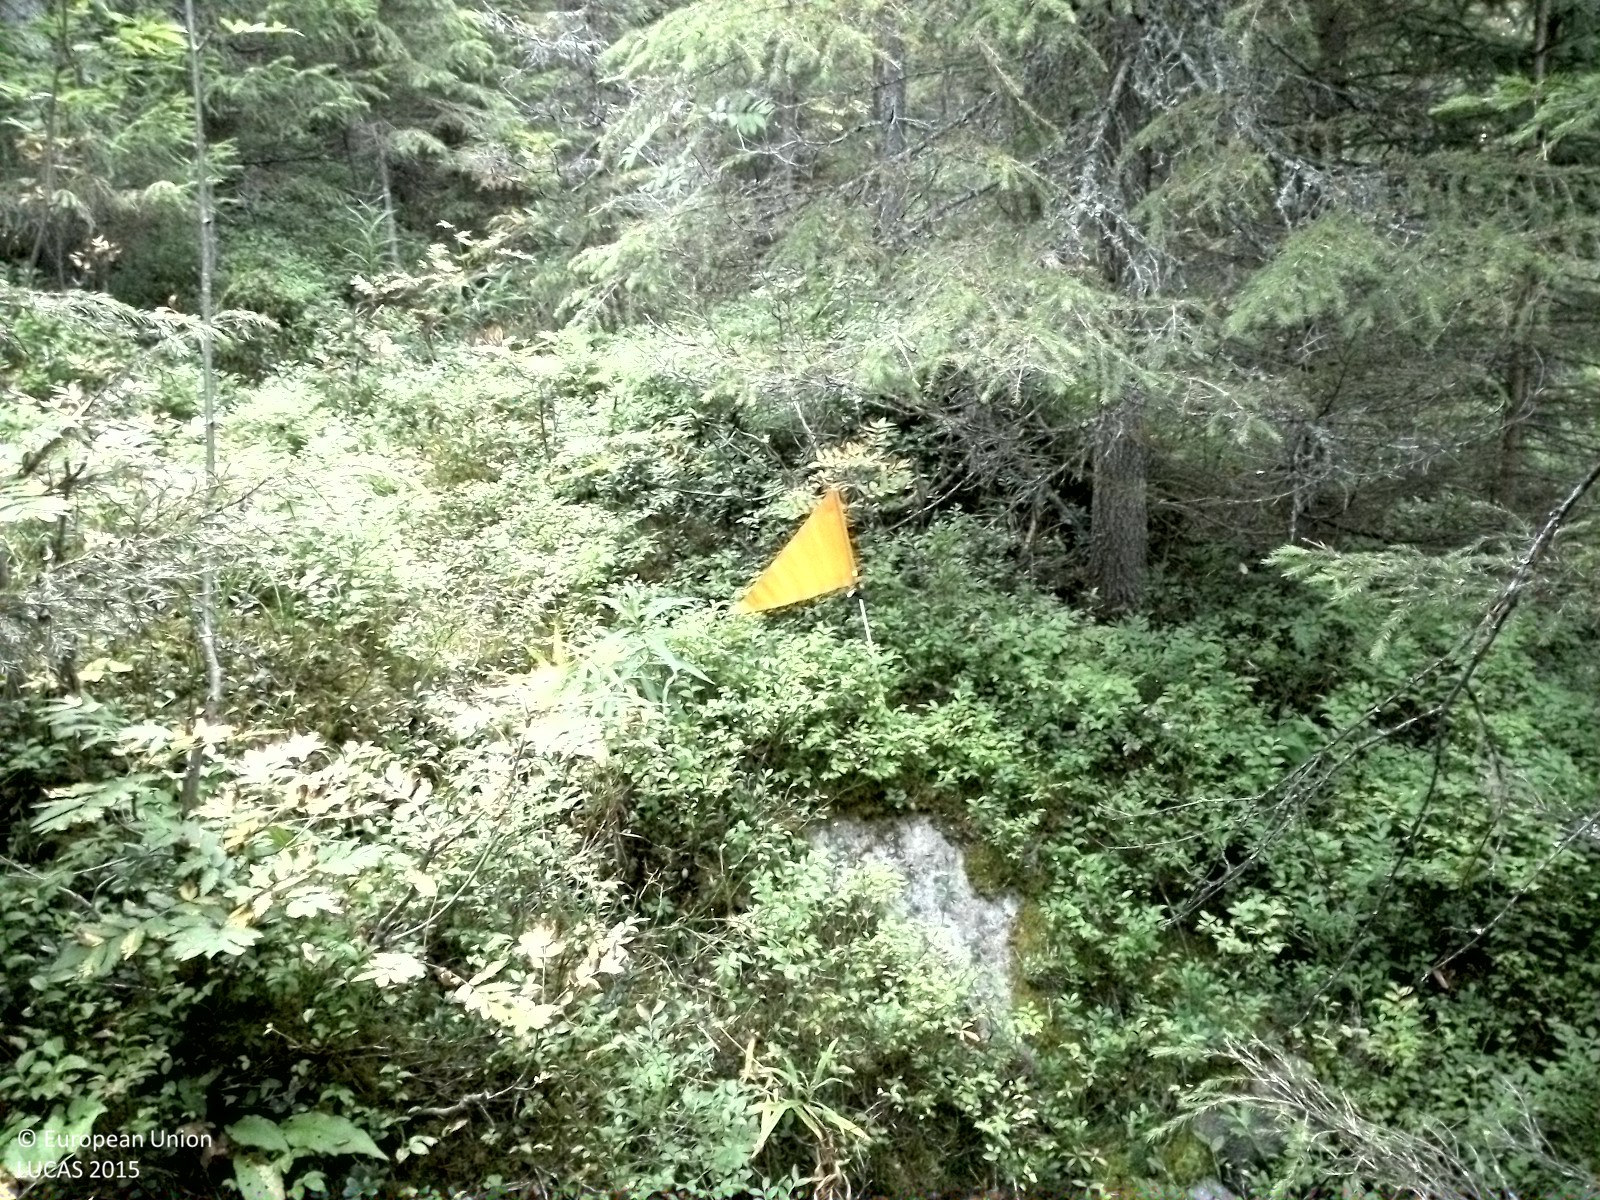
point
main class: Woodland
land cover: Spruce dominated coniferous woodland
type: boreal forest
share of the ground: 50 - 75 %
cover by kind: coniferous forest trees 60 %, shrubs 35 %, broadleaved forest trees 5 %
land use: Forestry
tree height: > 5 m
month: August
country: SE
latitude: 62.2753
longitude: 16.0112
